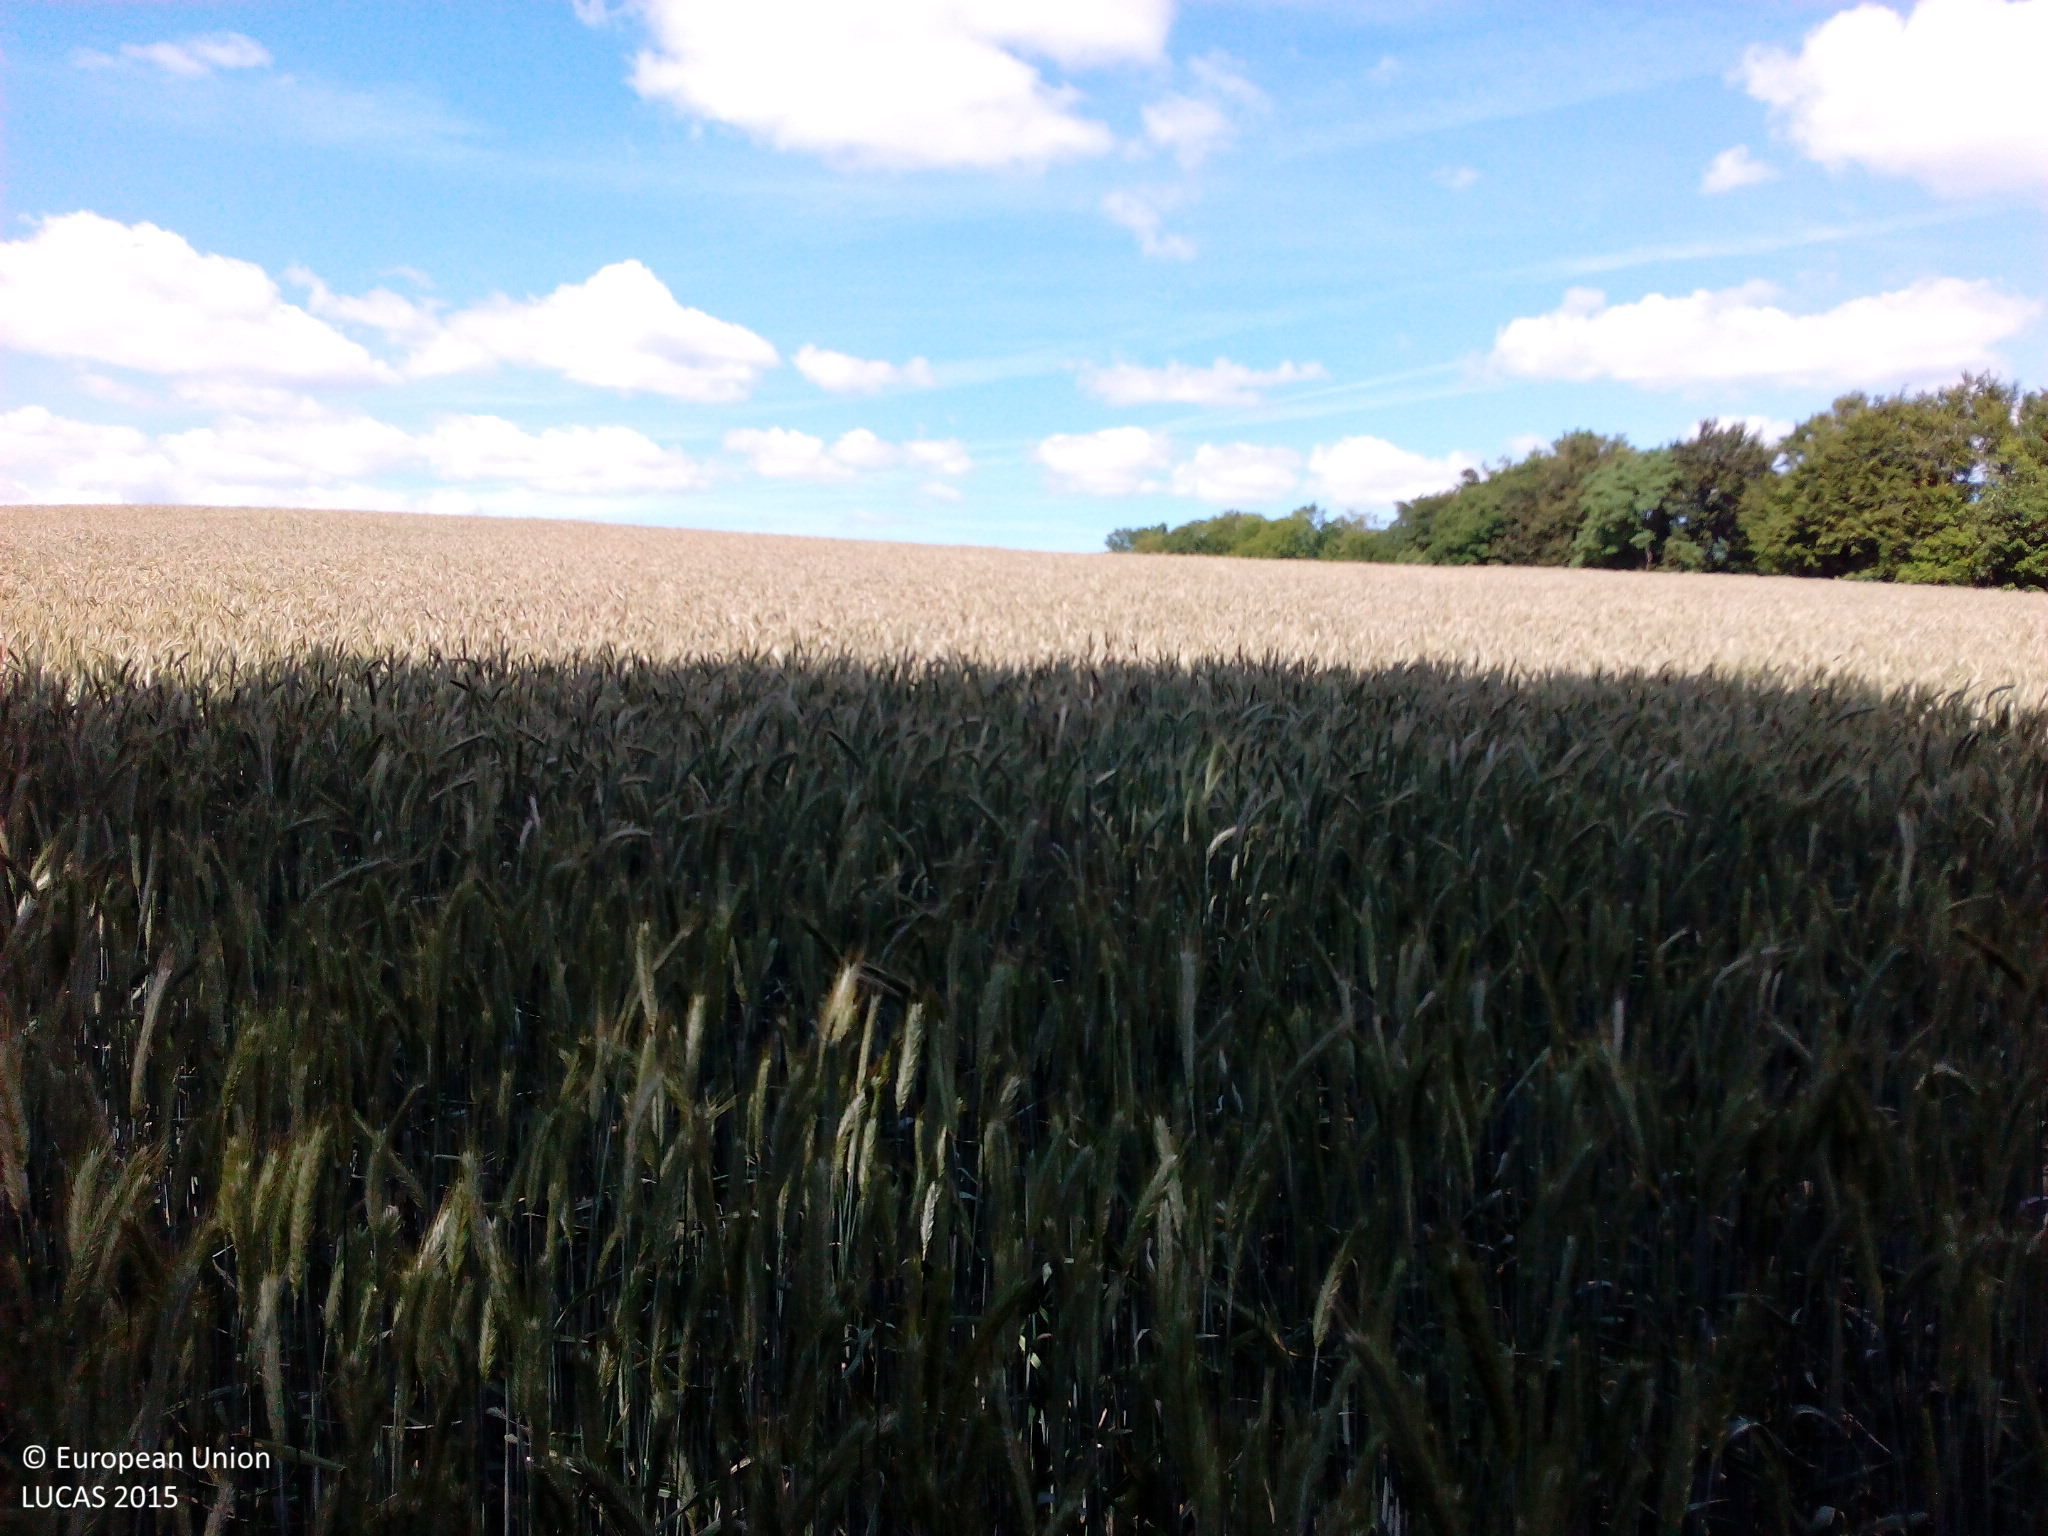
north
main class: Cropland
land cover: Rye
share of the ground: > 75 %
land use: Agriculture (excluding fallow land and kitchen gardens)
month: June
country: DK
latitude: 56.3291
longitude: 10.7915
